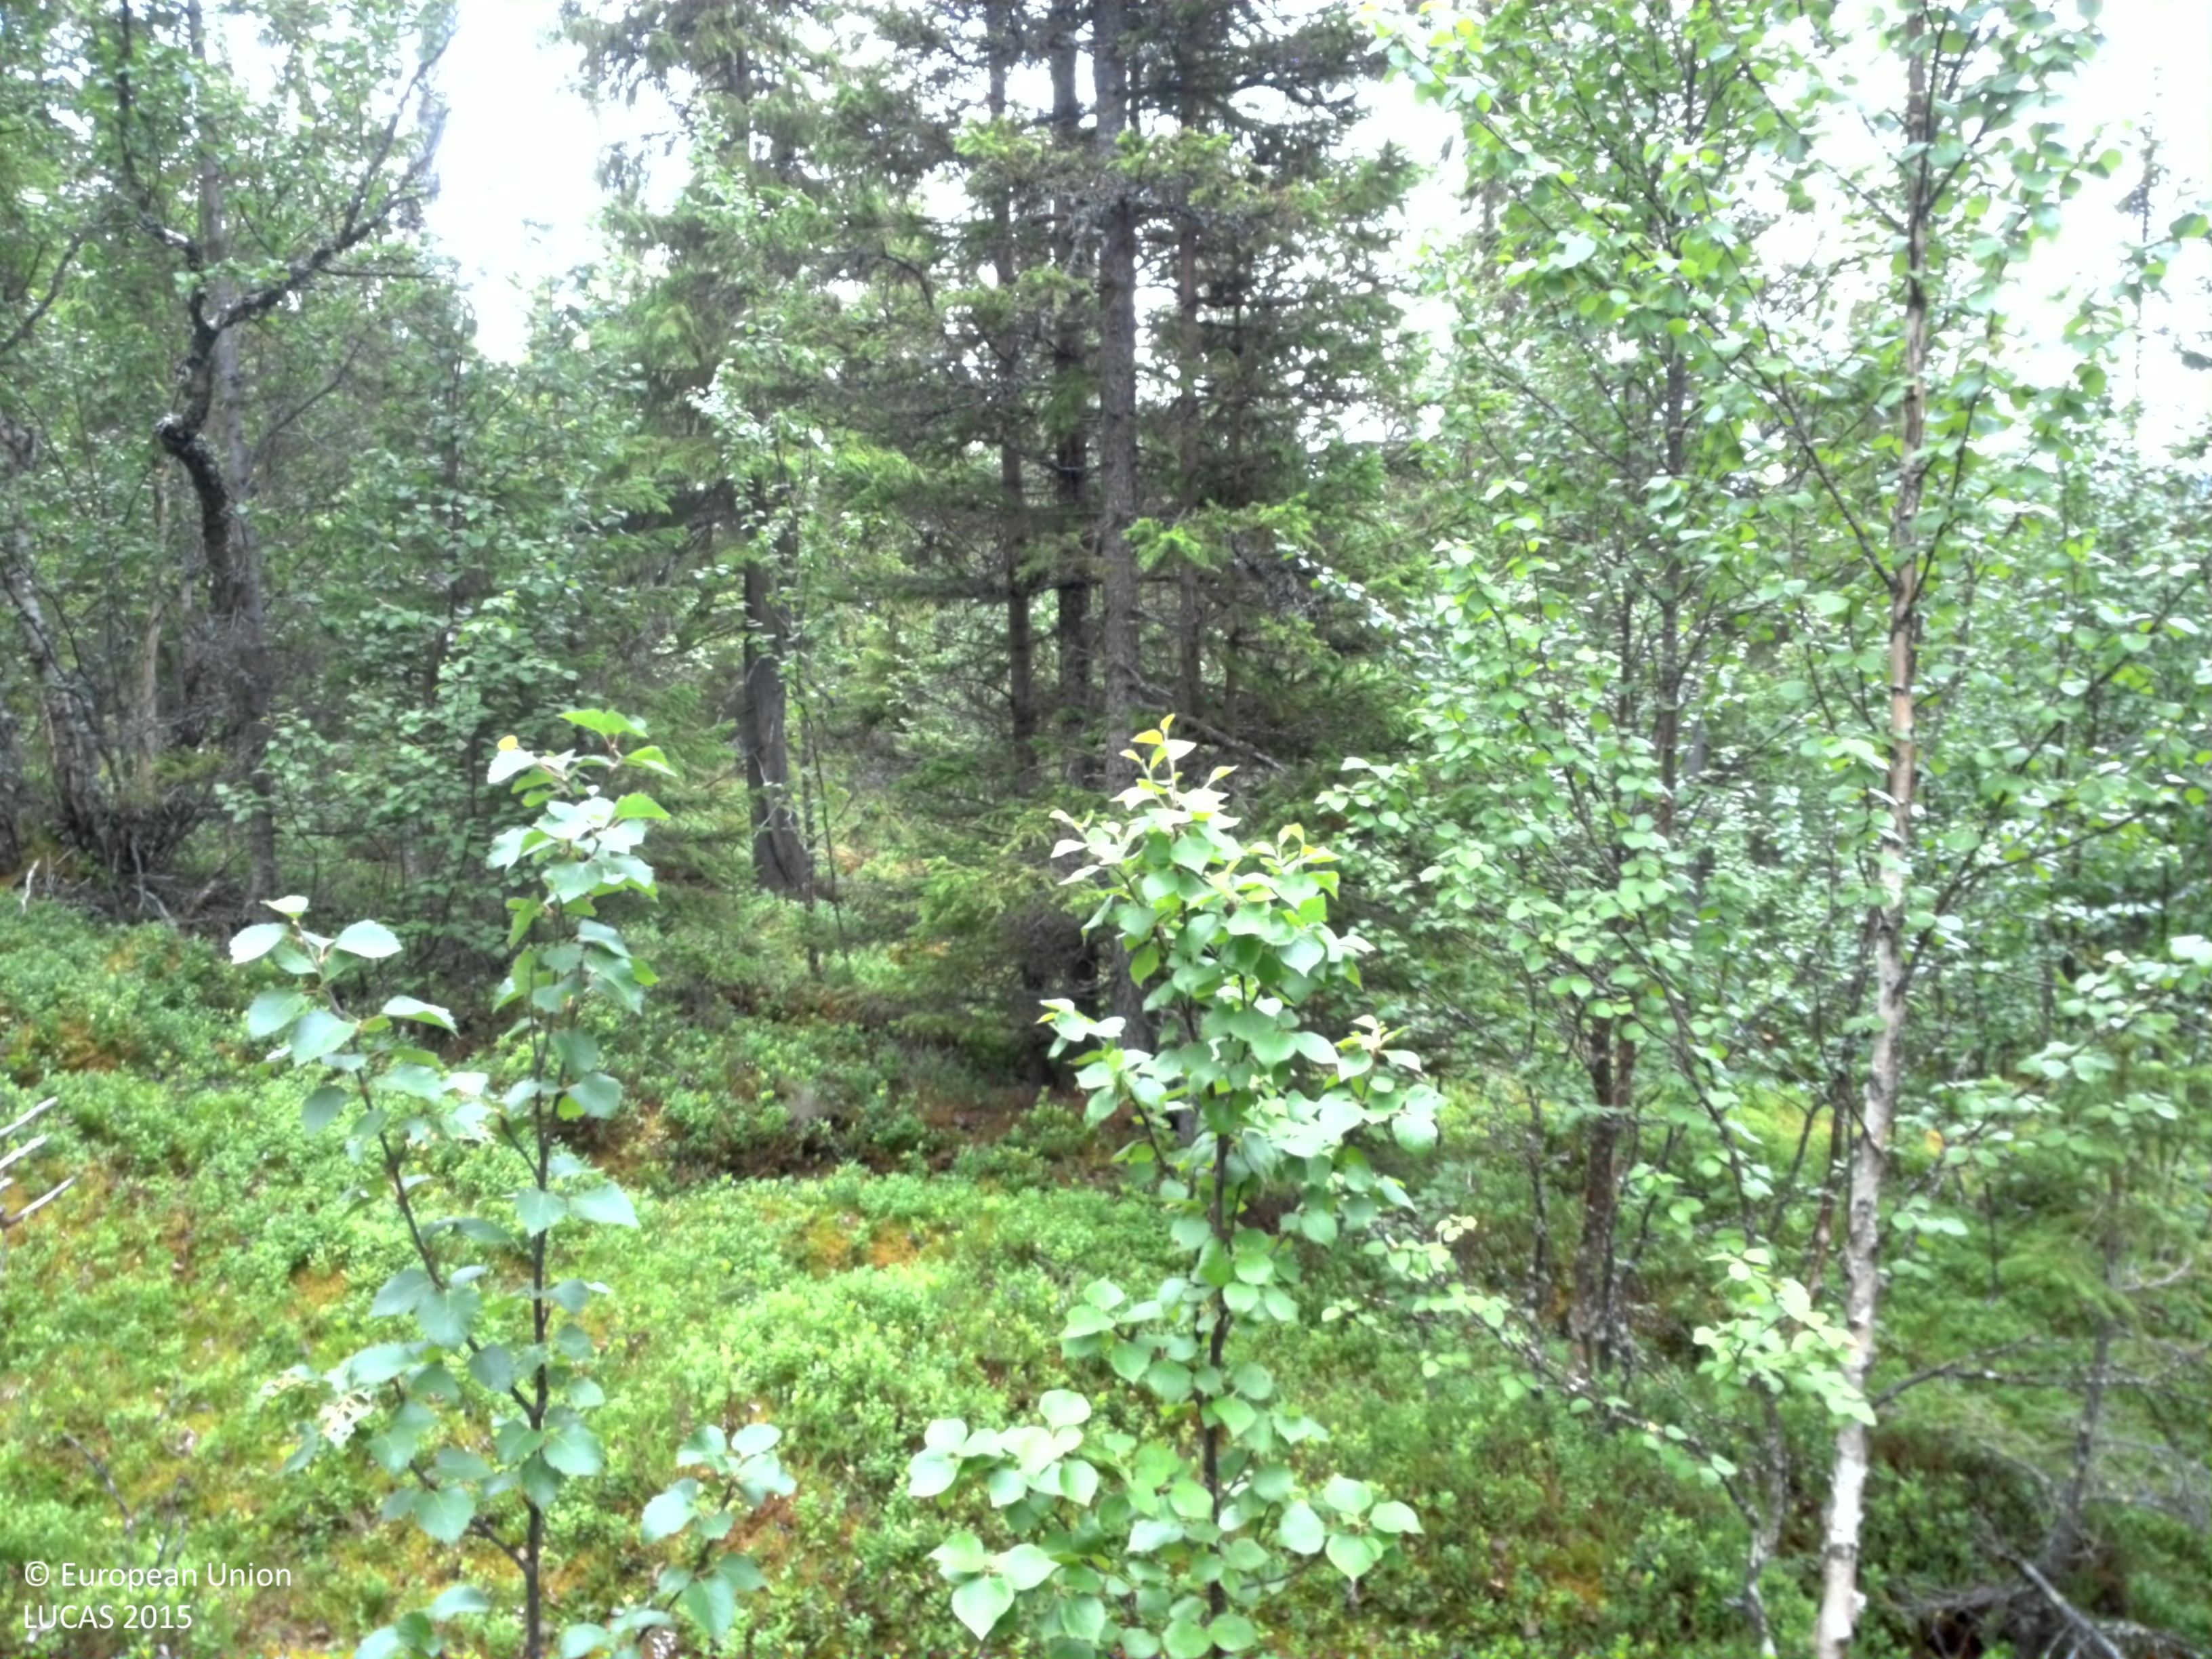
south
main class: Woodland
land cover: Spruce dominated mixed woodland
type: boreal forest
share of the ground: 25 - 50 %
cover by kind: shrubs 55 %, coniferous forest trees 20 %, broadleaved forest trees 15 %, lichens and mosses 10 %
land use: Forestry
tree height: > 5 m
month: August
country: SE
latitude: 65.2520
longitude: 15.8095
